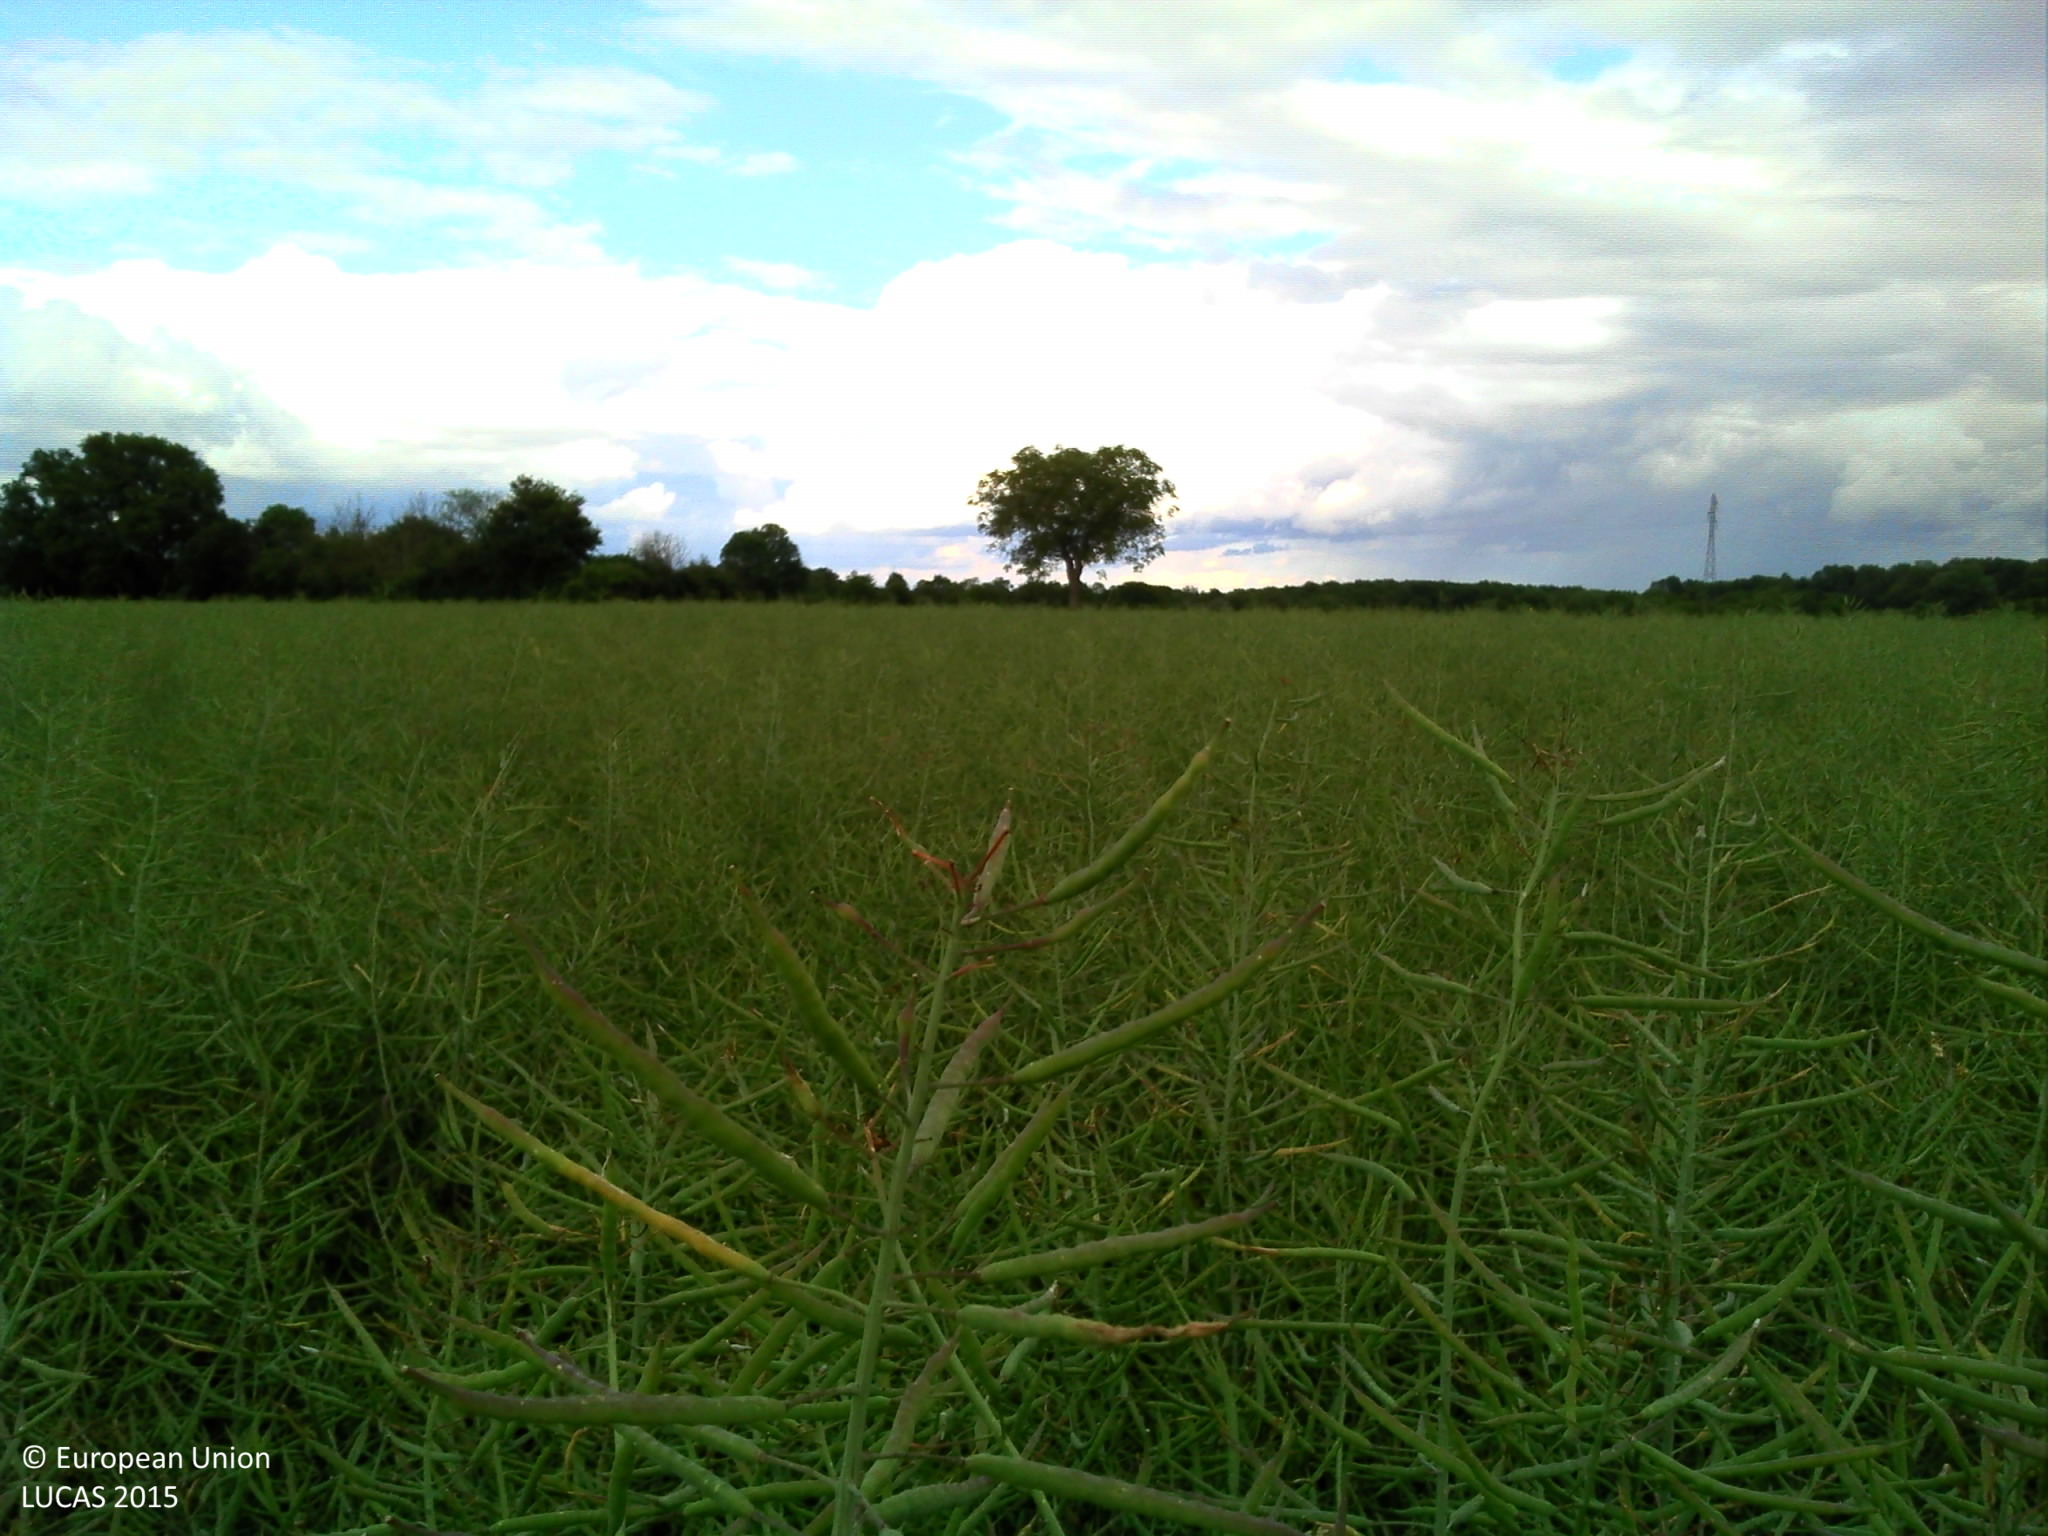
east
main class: Cropland
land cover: Rape and turnip rape
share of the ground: > 75 %
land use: Agriculture (excluding fallow land and kitchen gardens)
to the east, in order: Rape and turnip rape; Grass margins; Tracks; Grass margins; Common wheat; Grassland without tree/shrub cover
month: May
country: FR
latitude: 47.4293
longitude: 2.8214
